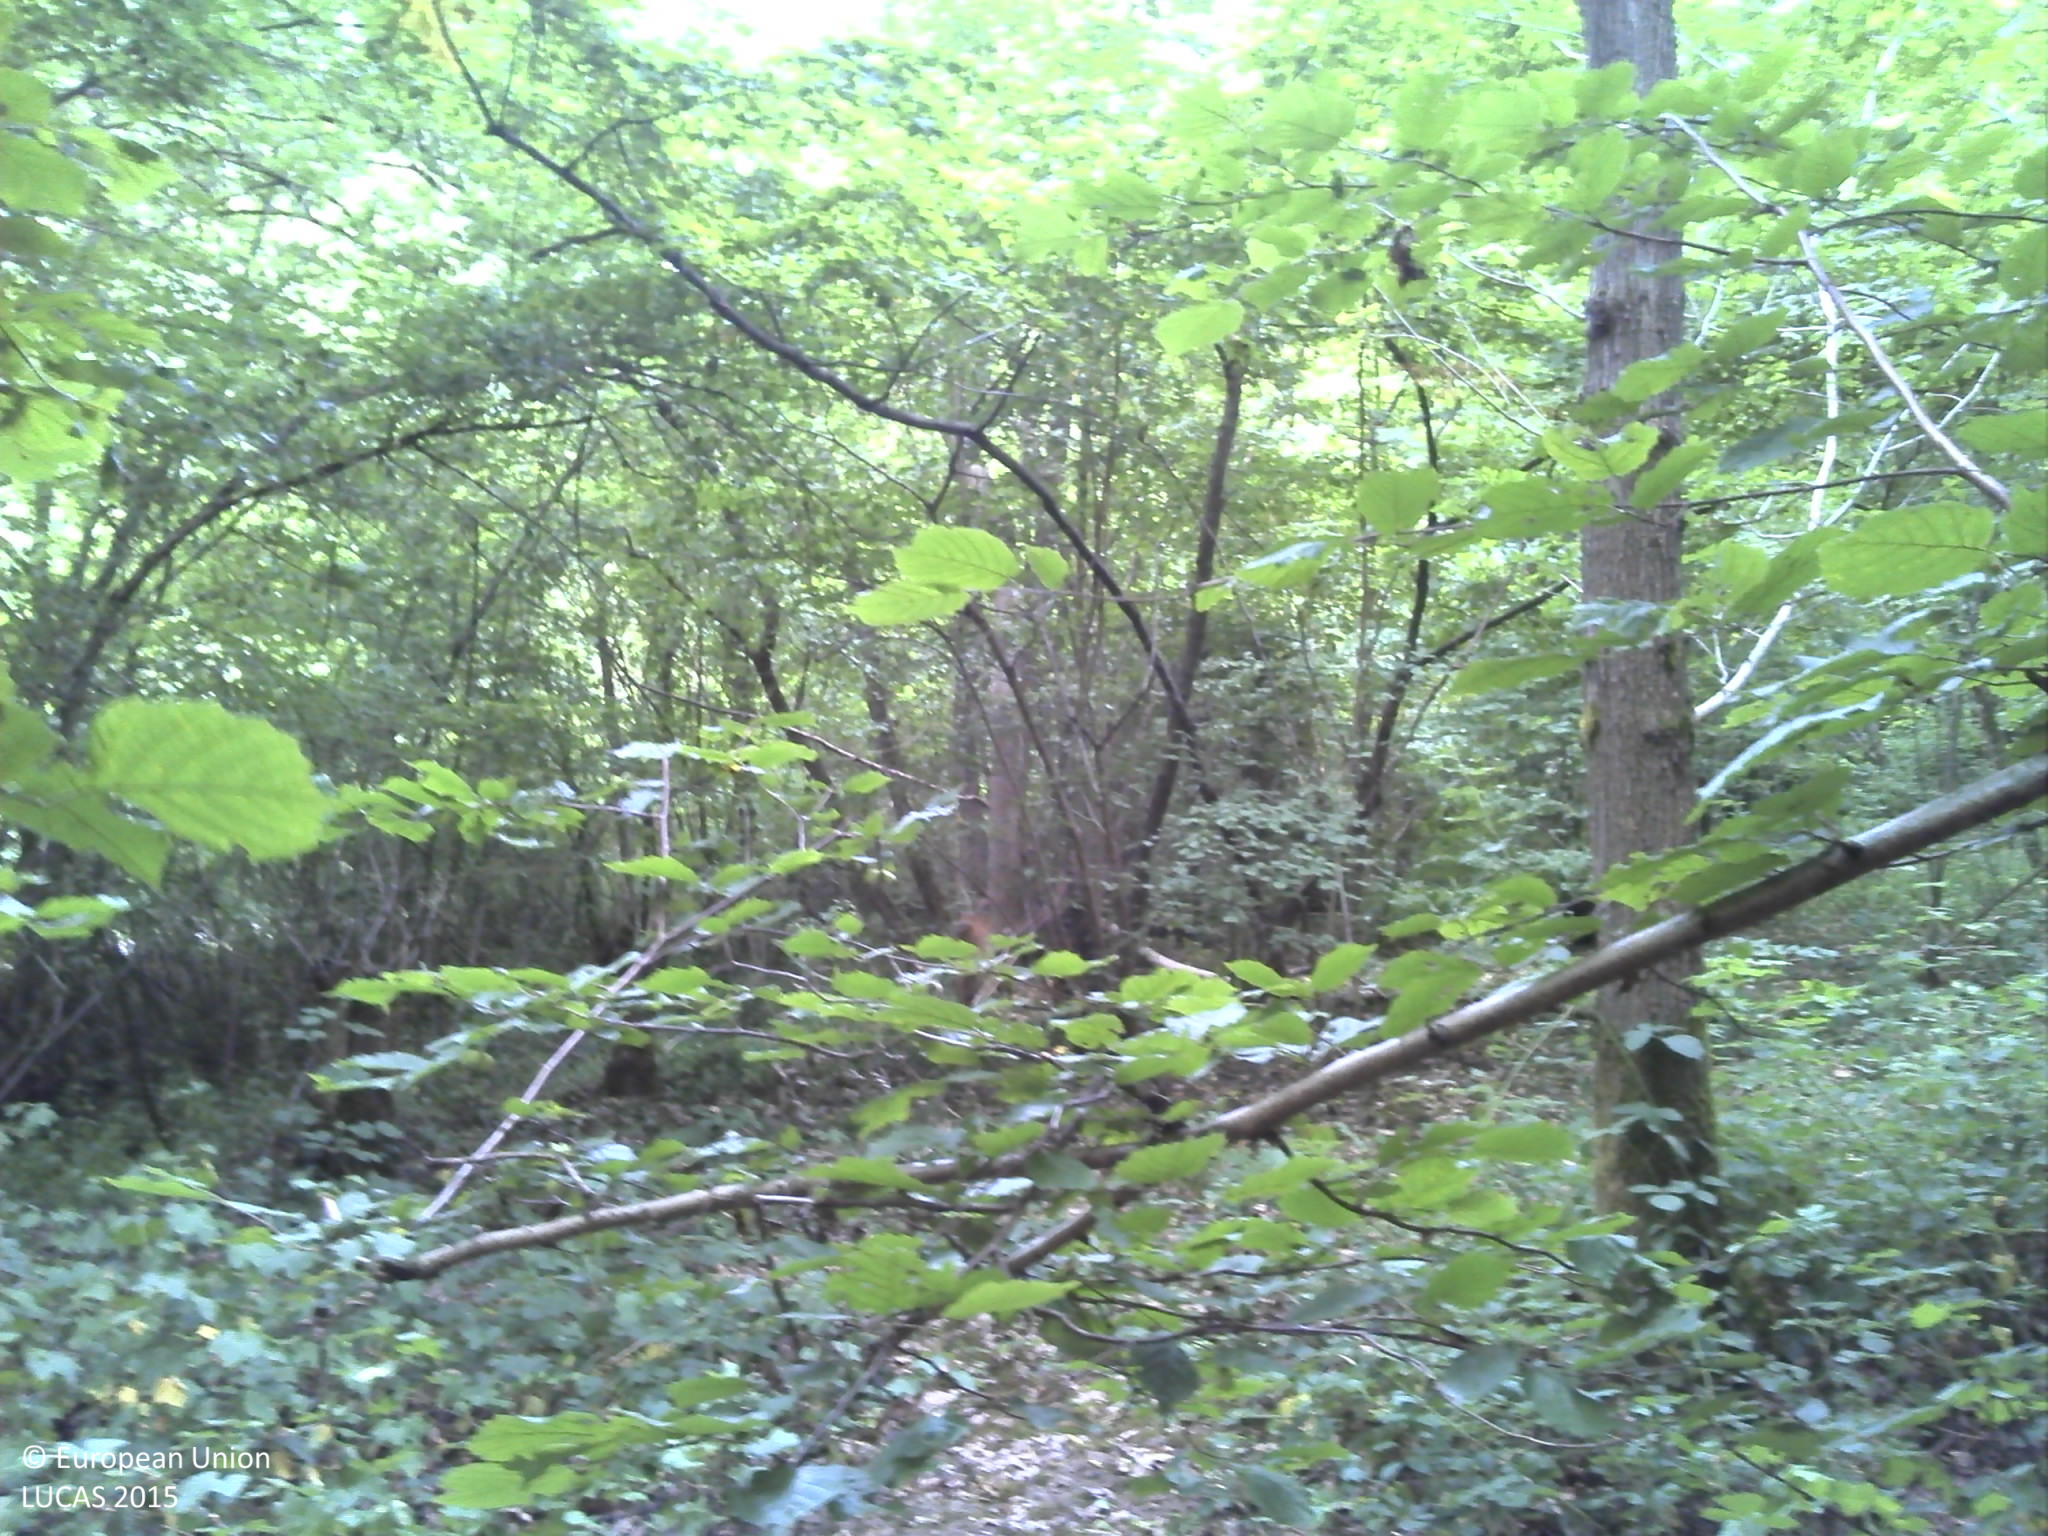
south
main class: Woodland
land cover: Broadleaved woodland
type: floodplain forest
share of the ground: > 75 %
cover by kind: broadleaved forest trees 90 %, herbaceous plants 10 %
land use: Forestry
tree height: > 5 m
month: July
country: FR
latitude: 48.5799
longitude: 2.4660
